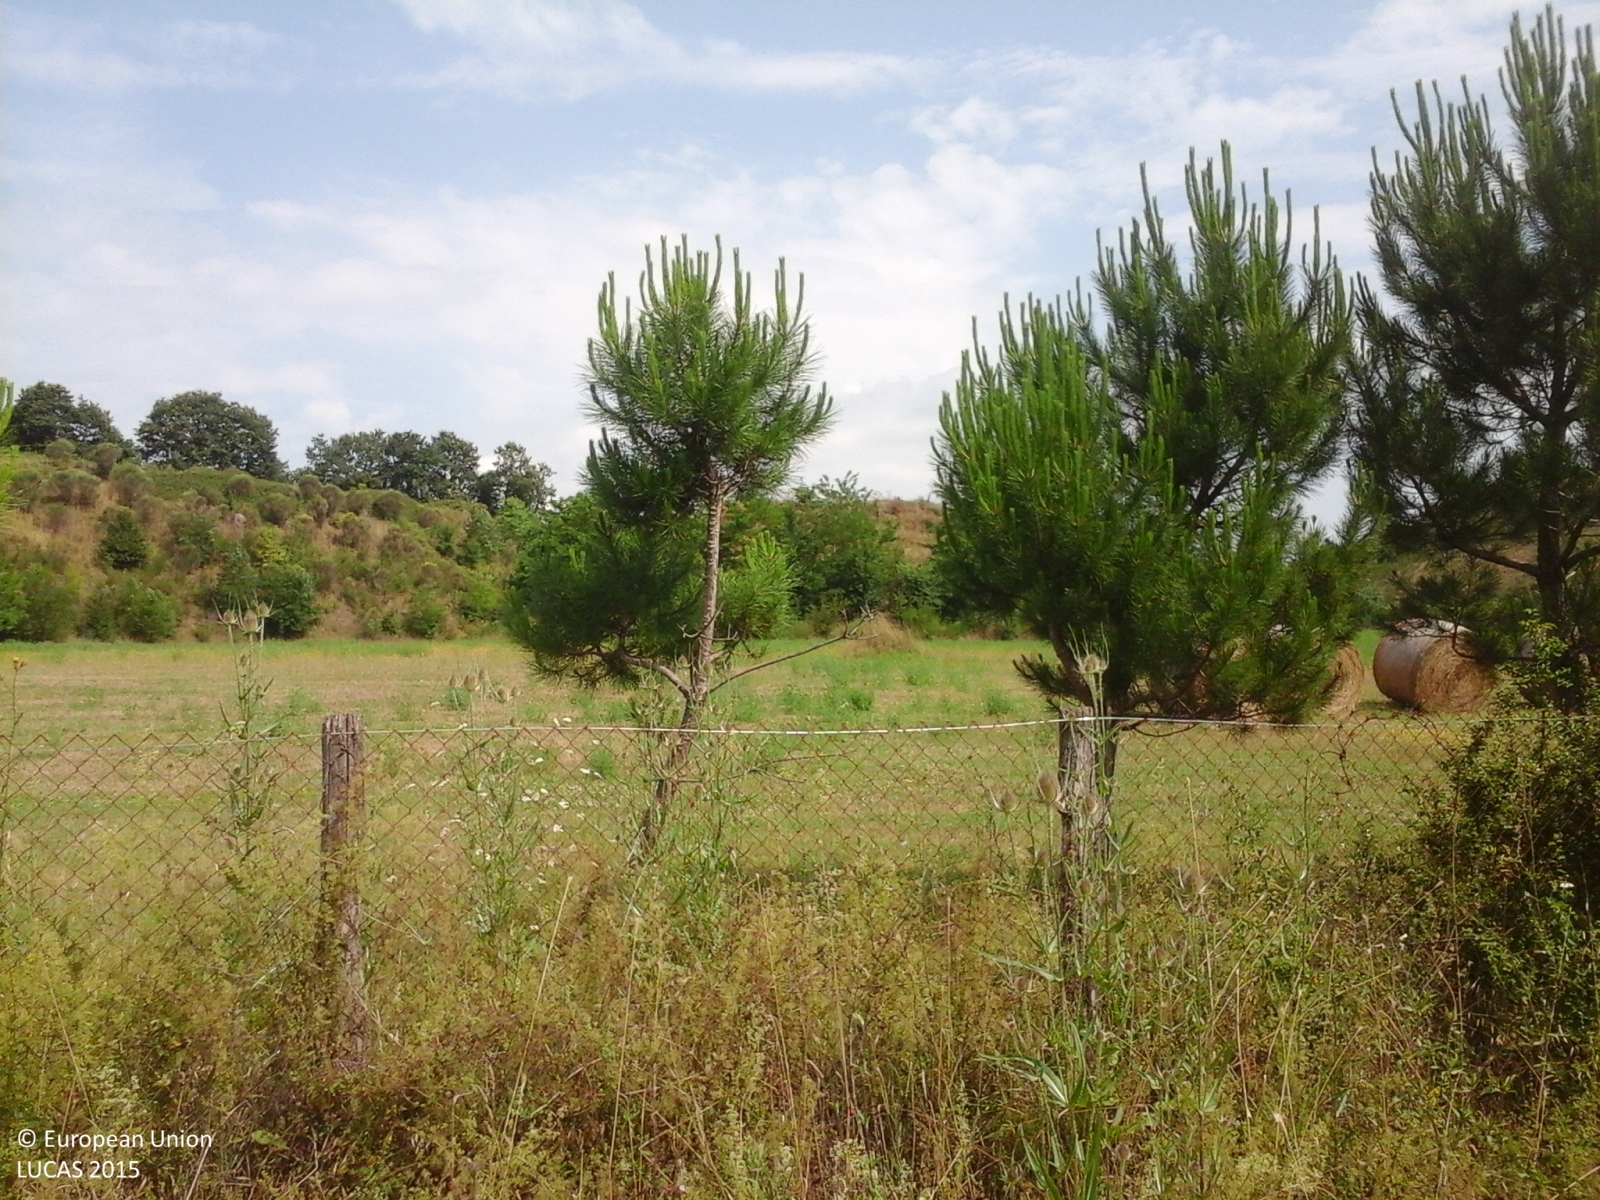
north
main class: Cropland
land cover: Temporary grasslands
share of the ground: > 75 %
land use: Agriculture (excluding fallow land and kitchen gardens)
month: June
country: IT
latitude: 41.7604
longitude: 12.9837
